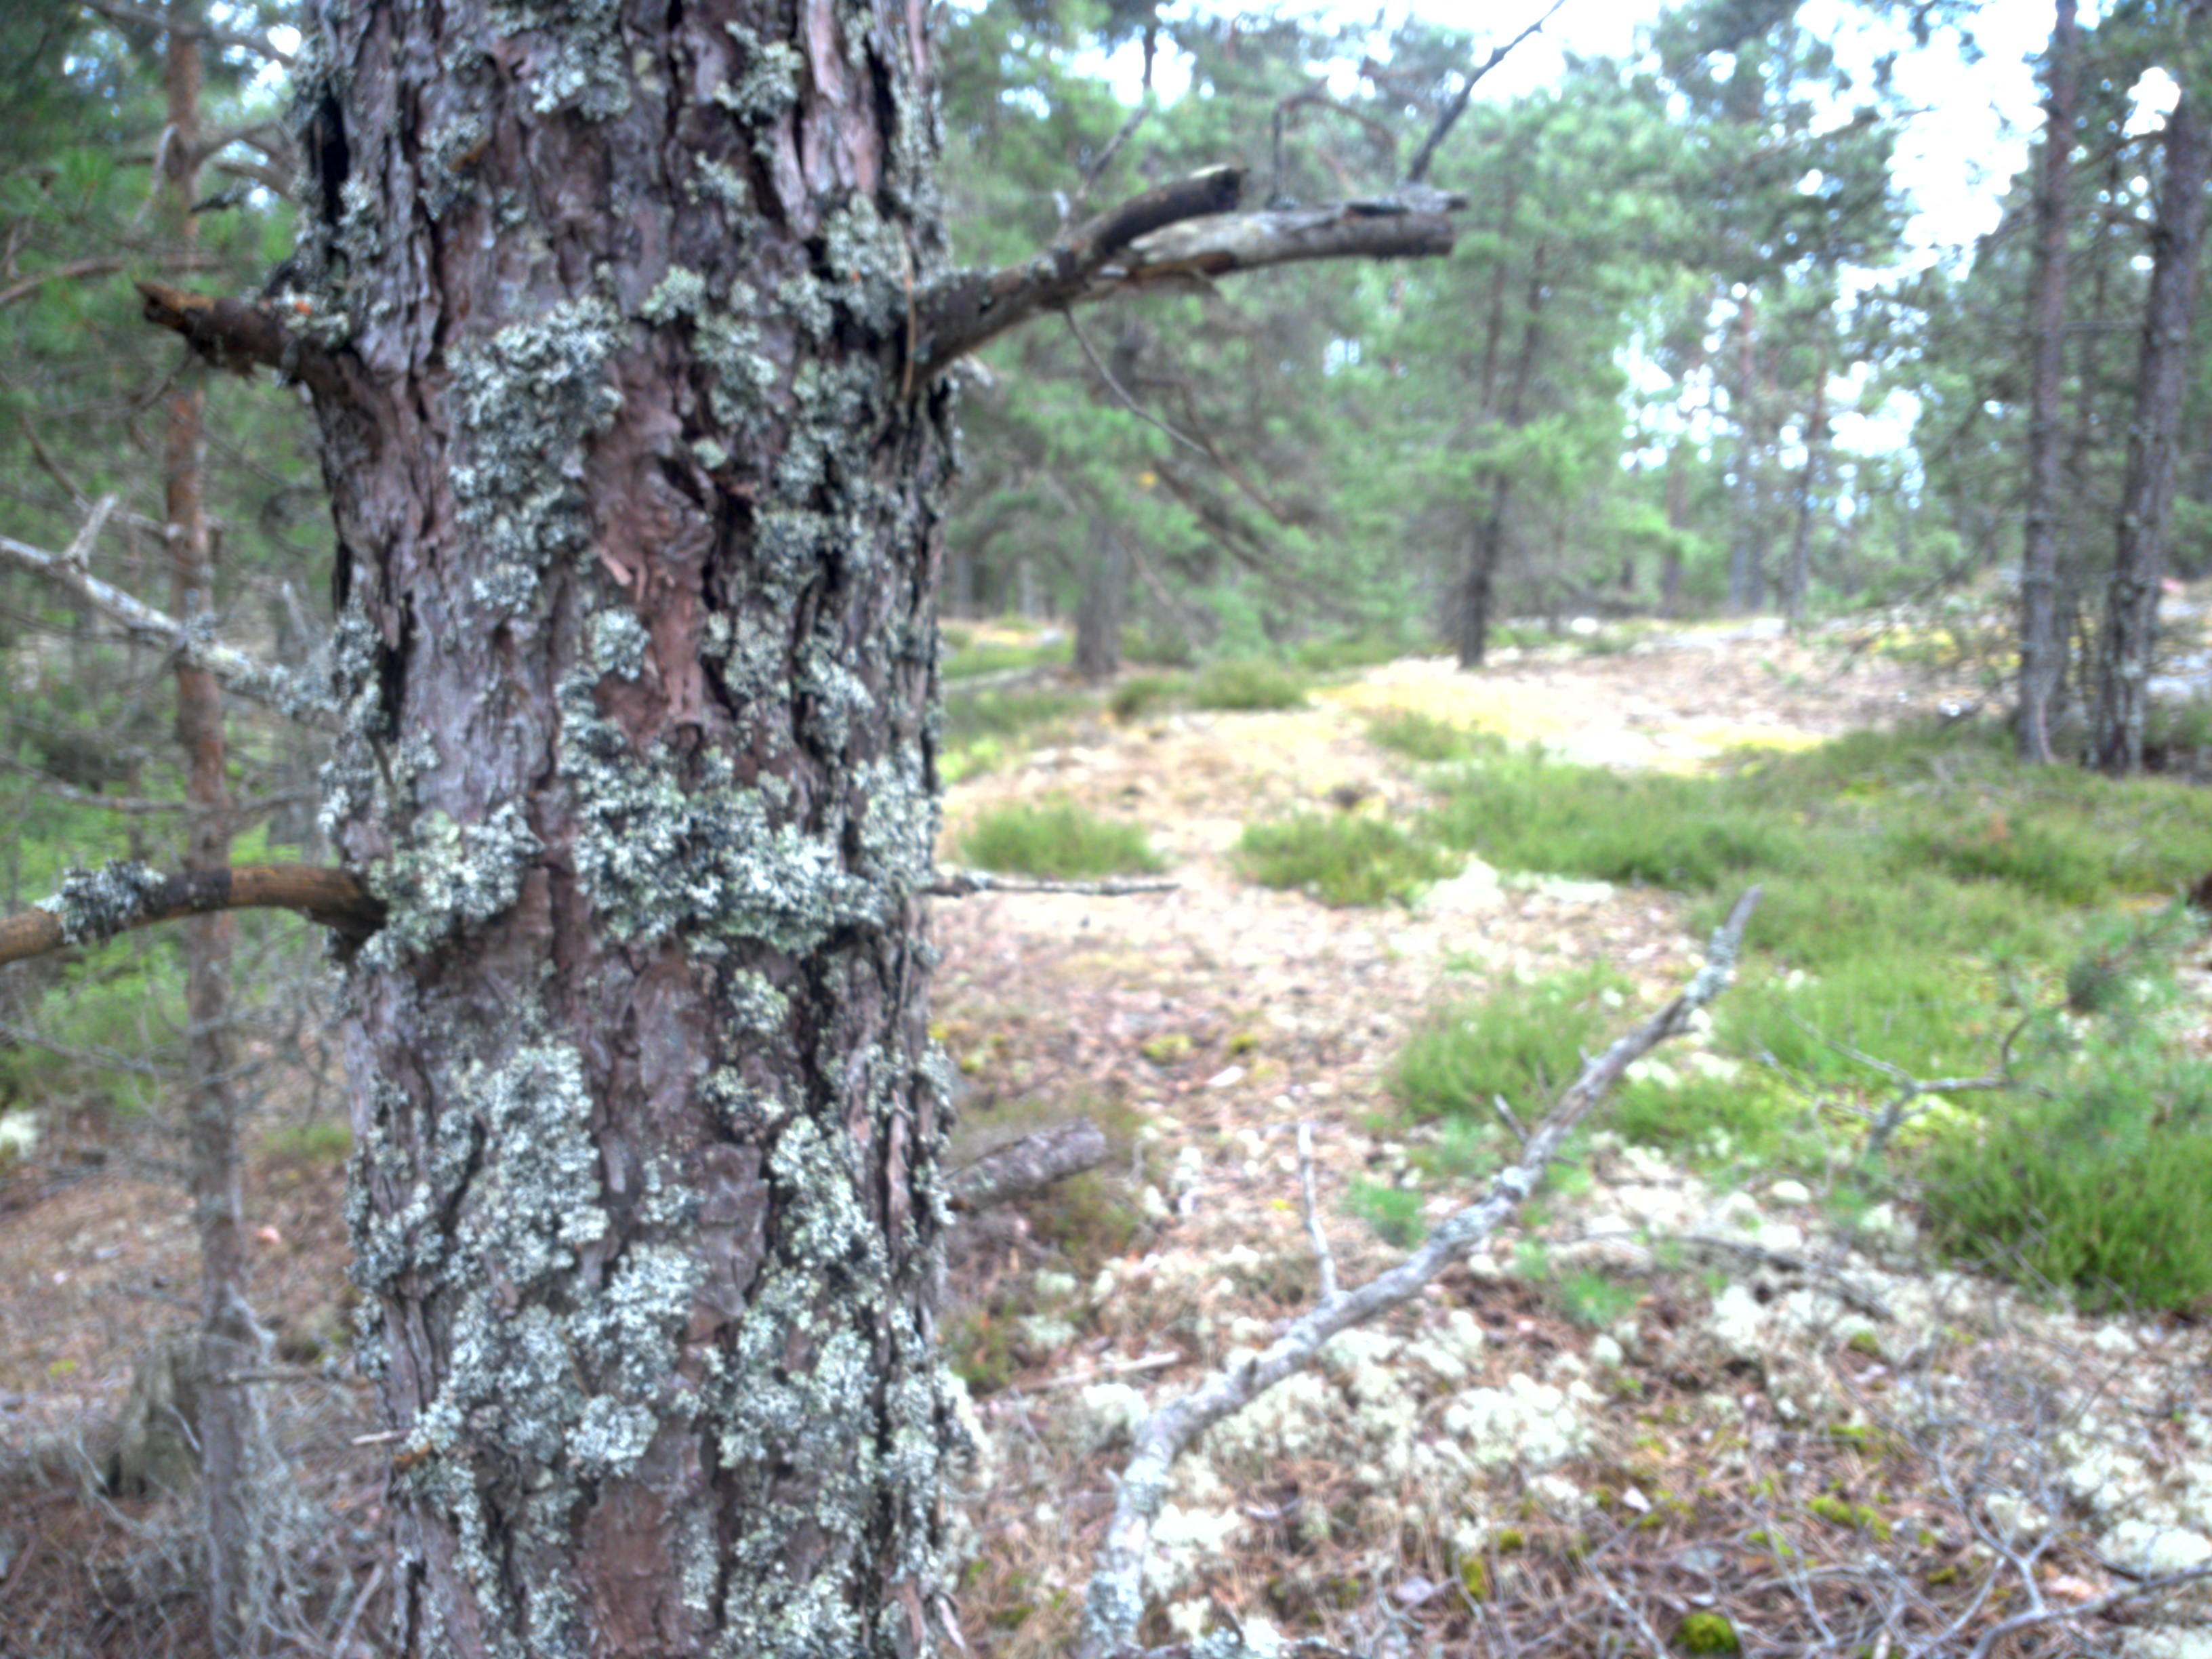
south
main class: Woodland
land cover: Pine dominated coniferous woodland
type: boreal forest
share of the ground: 25 - 50 %
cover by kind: shrubs 35 %, lichens and mosses 35 %, coniferous forest trees 30 %
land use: Forestry
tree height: > 5 m
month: July
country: SE
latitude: 59.0917
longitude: 18.1862
